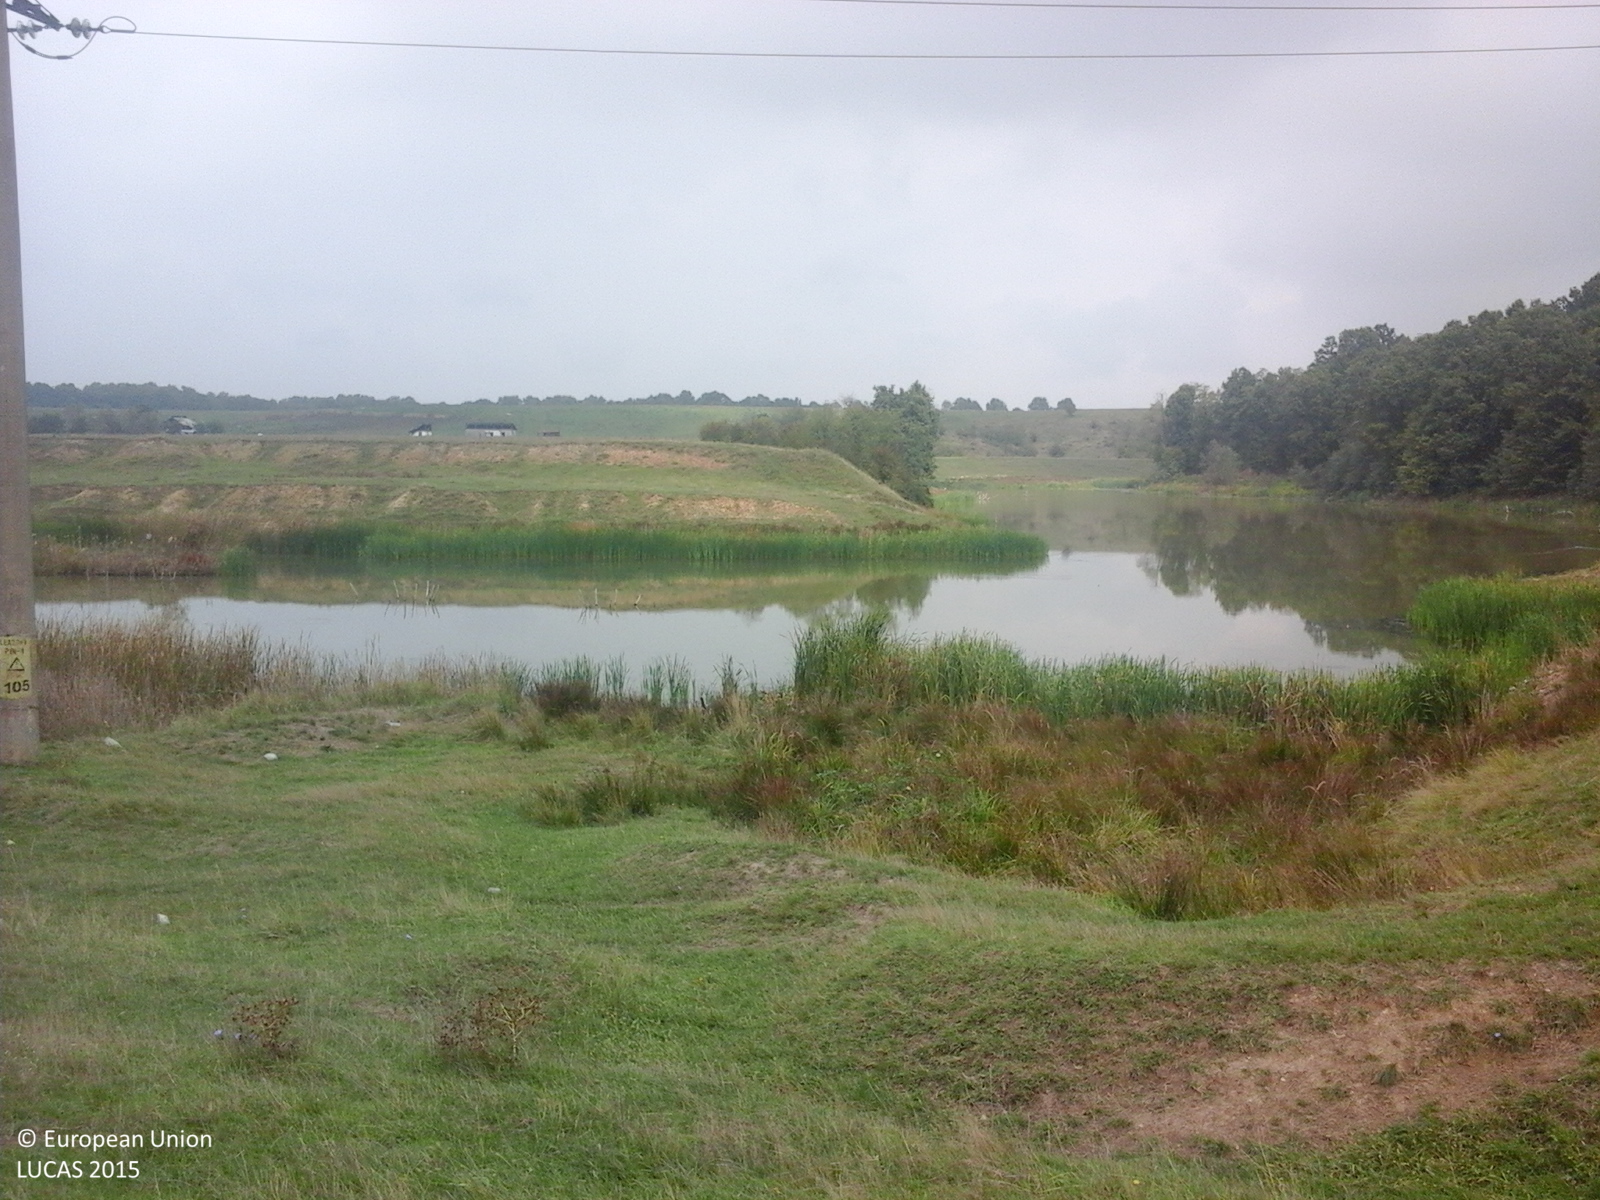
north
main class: Grassland
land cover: Grassland without tree/shrub cover
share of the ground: > 75 %
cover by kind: herbaceous plants 100 %
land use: Agriculture (excluding fallow land and kitchen gardens)
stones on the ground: < 10 %
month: September
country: RO
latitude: 44.9407
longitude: 23.0906
